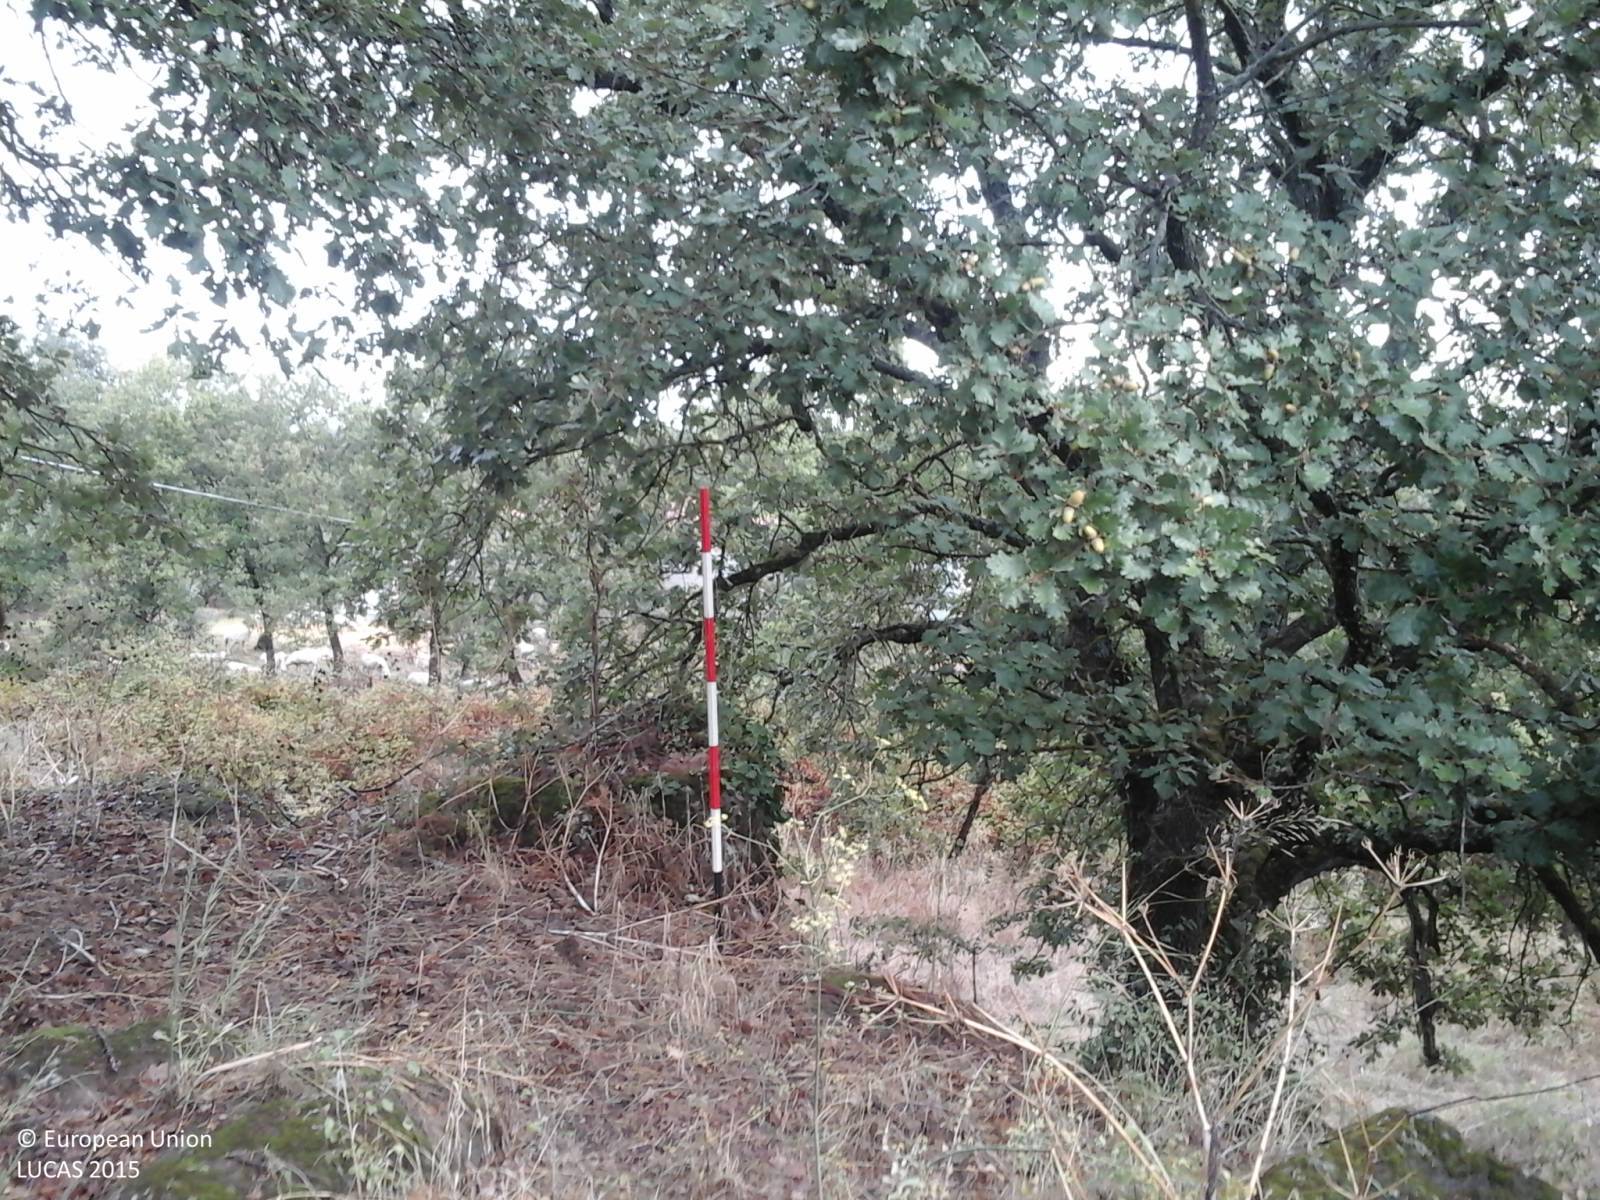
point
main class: Woodland
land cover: Broadleaved woodland
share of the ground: > 75 %
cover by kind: broadleaved forest trees 50 %, herbaceous plants 35 %, shrubs 15 %
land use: Agriculture (excluding fallow land and kitchen gardens)
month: October
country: IT
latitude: 40.0979
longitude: 8.8683
